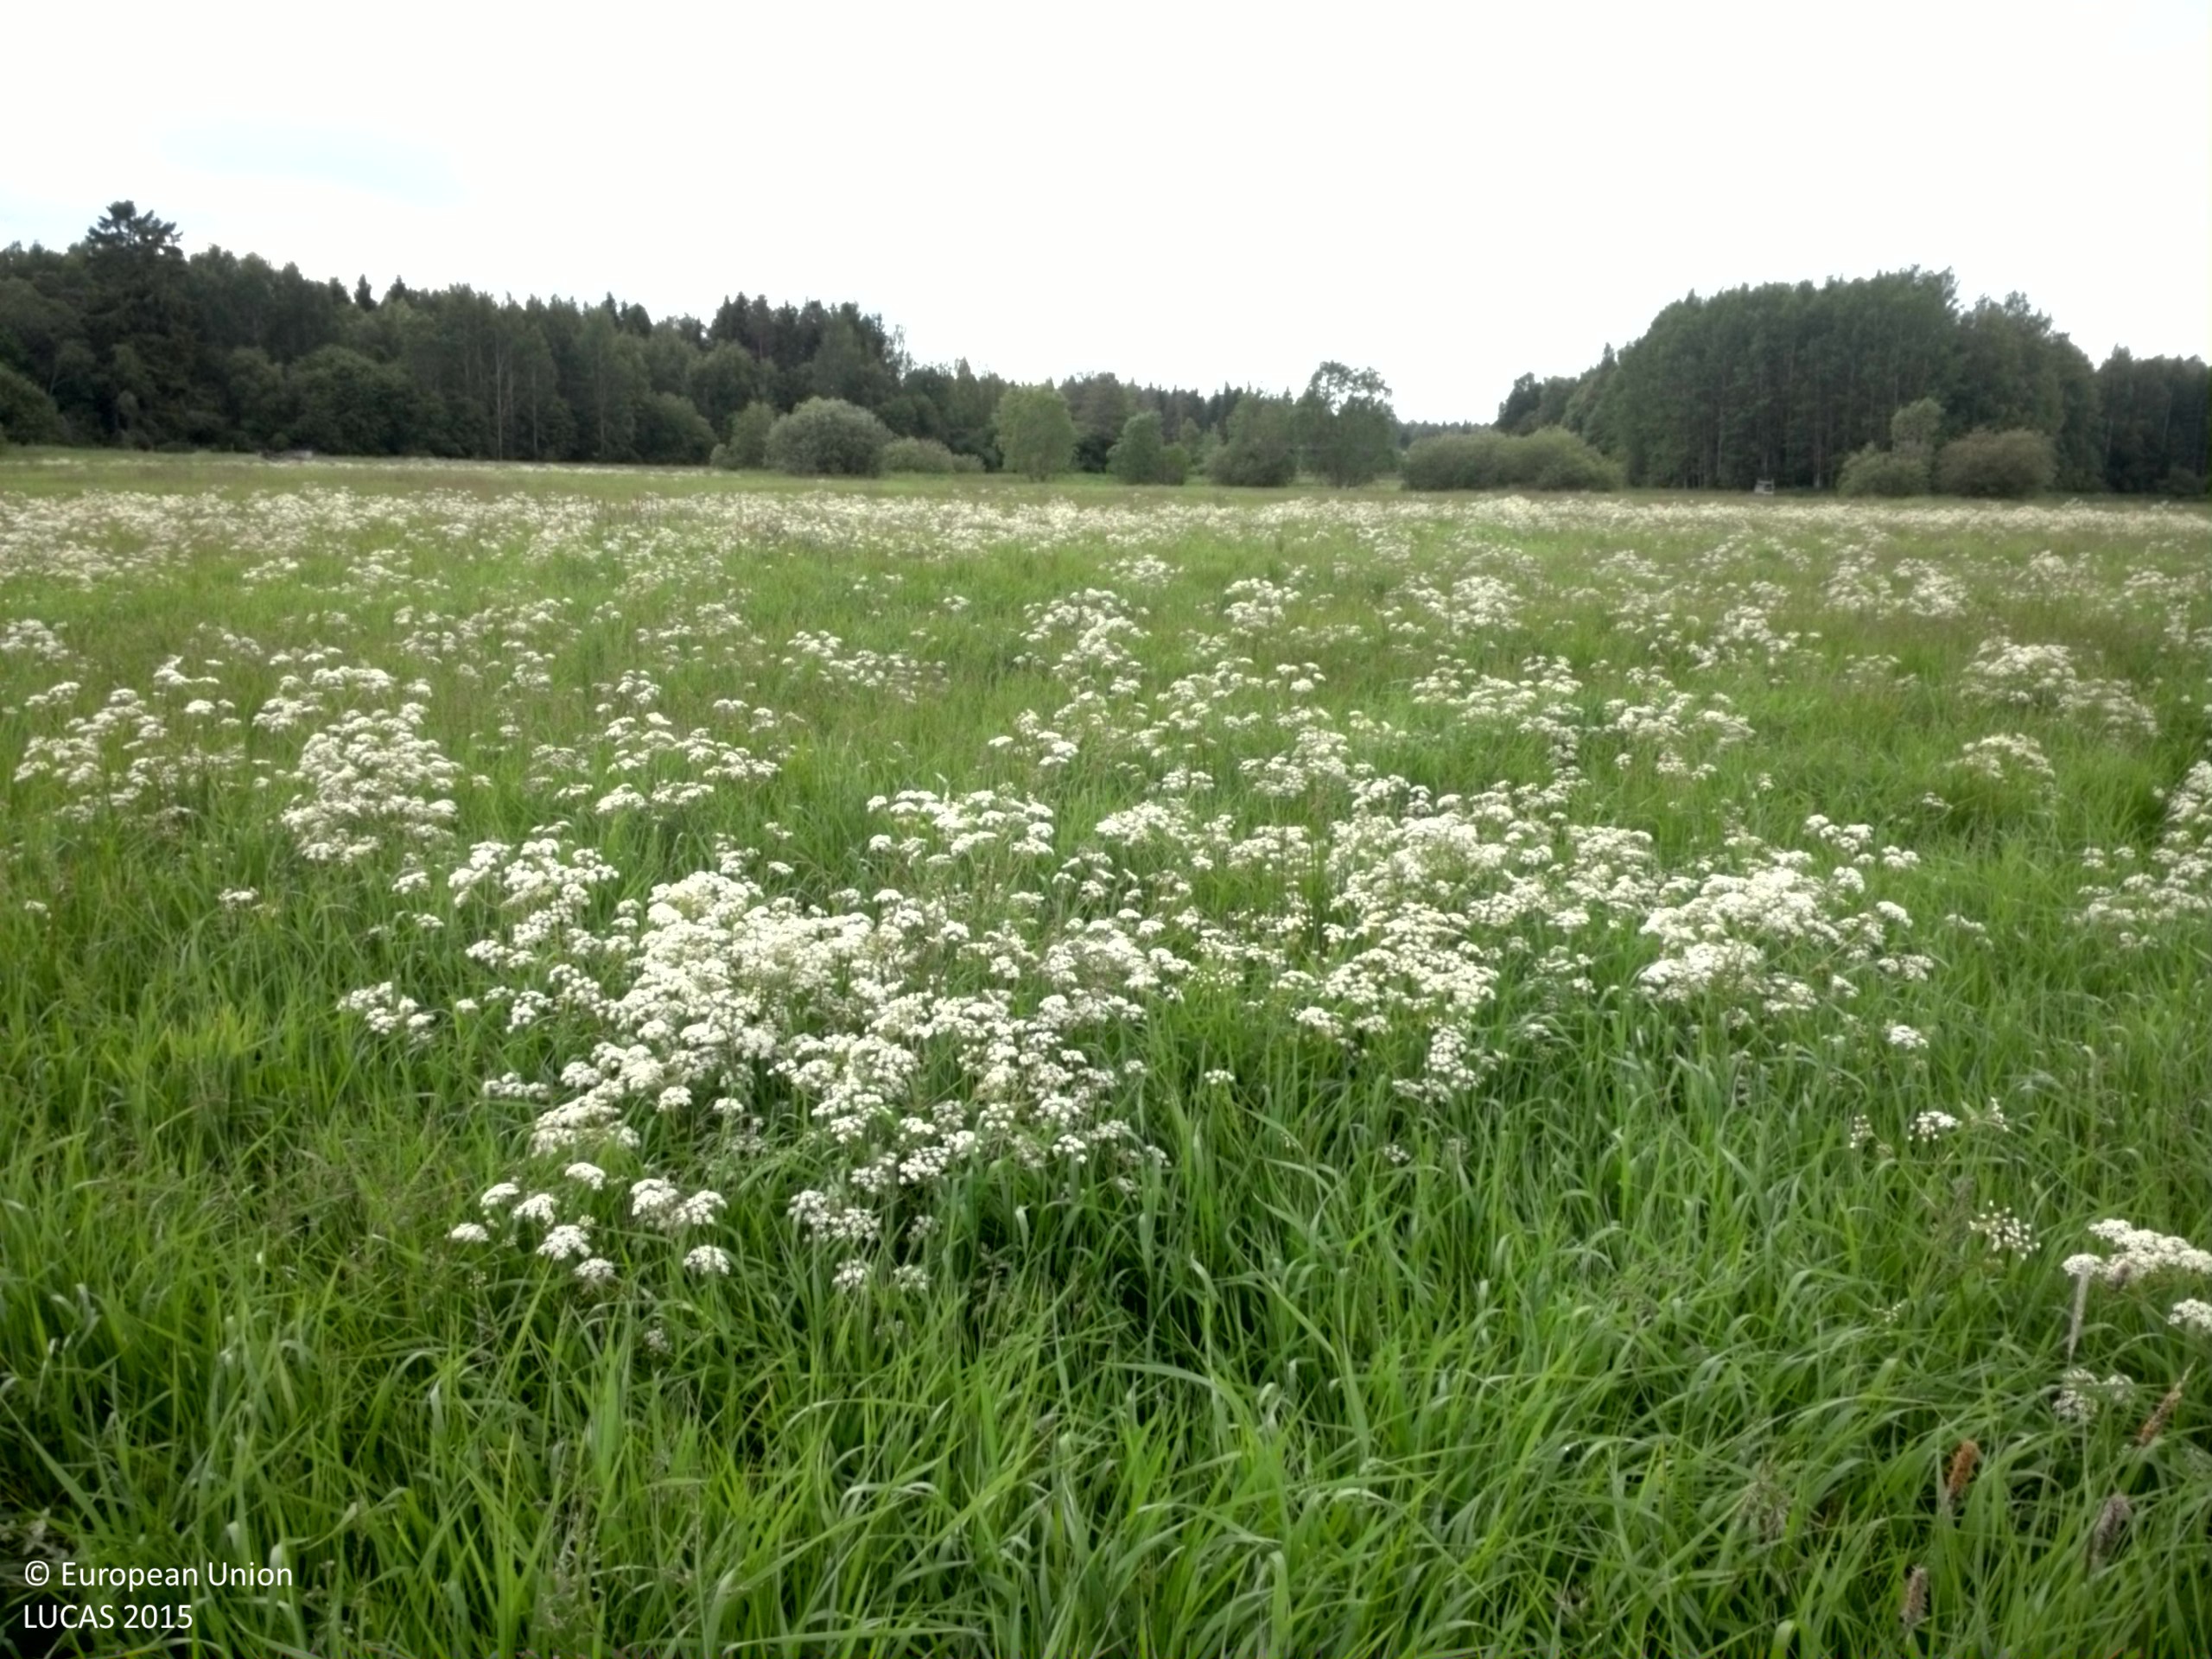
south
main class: Cropland
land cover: Temporary grasslands
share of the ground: > 75 %
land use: Agriculture (excluding fallow land and kitchen gardens)
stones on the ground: < 10 %
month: June
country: SE
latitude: 60.2433
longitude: 17.6694
